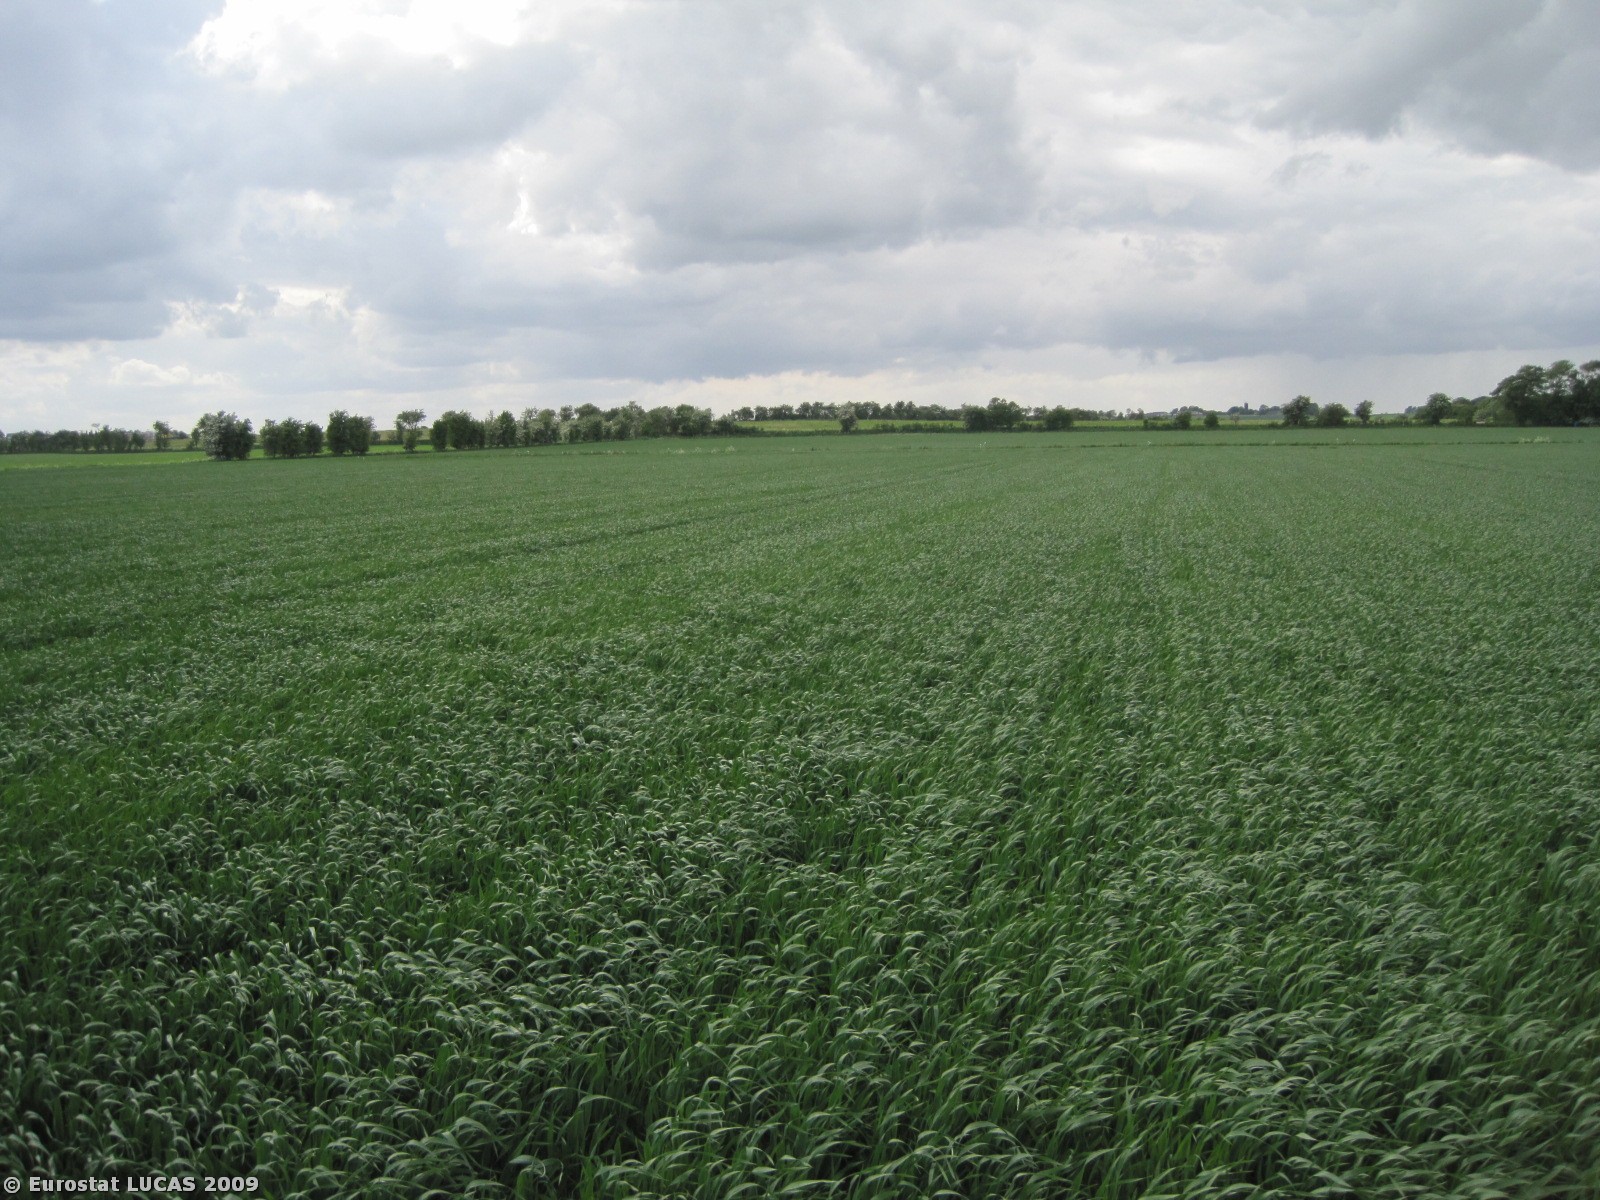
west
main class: Cropland
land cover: Oats
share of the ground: > 75 %
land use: Agriculture (excluding fallow land and kitchen gardens)
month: May
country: DK
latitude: 56.5113
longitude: 10.0487
